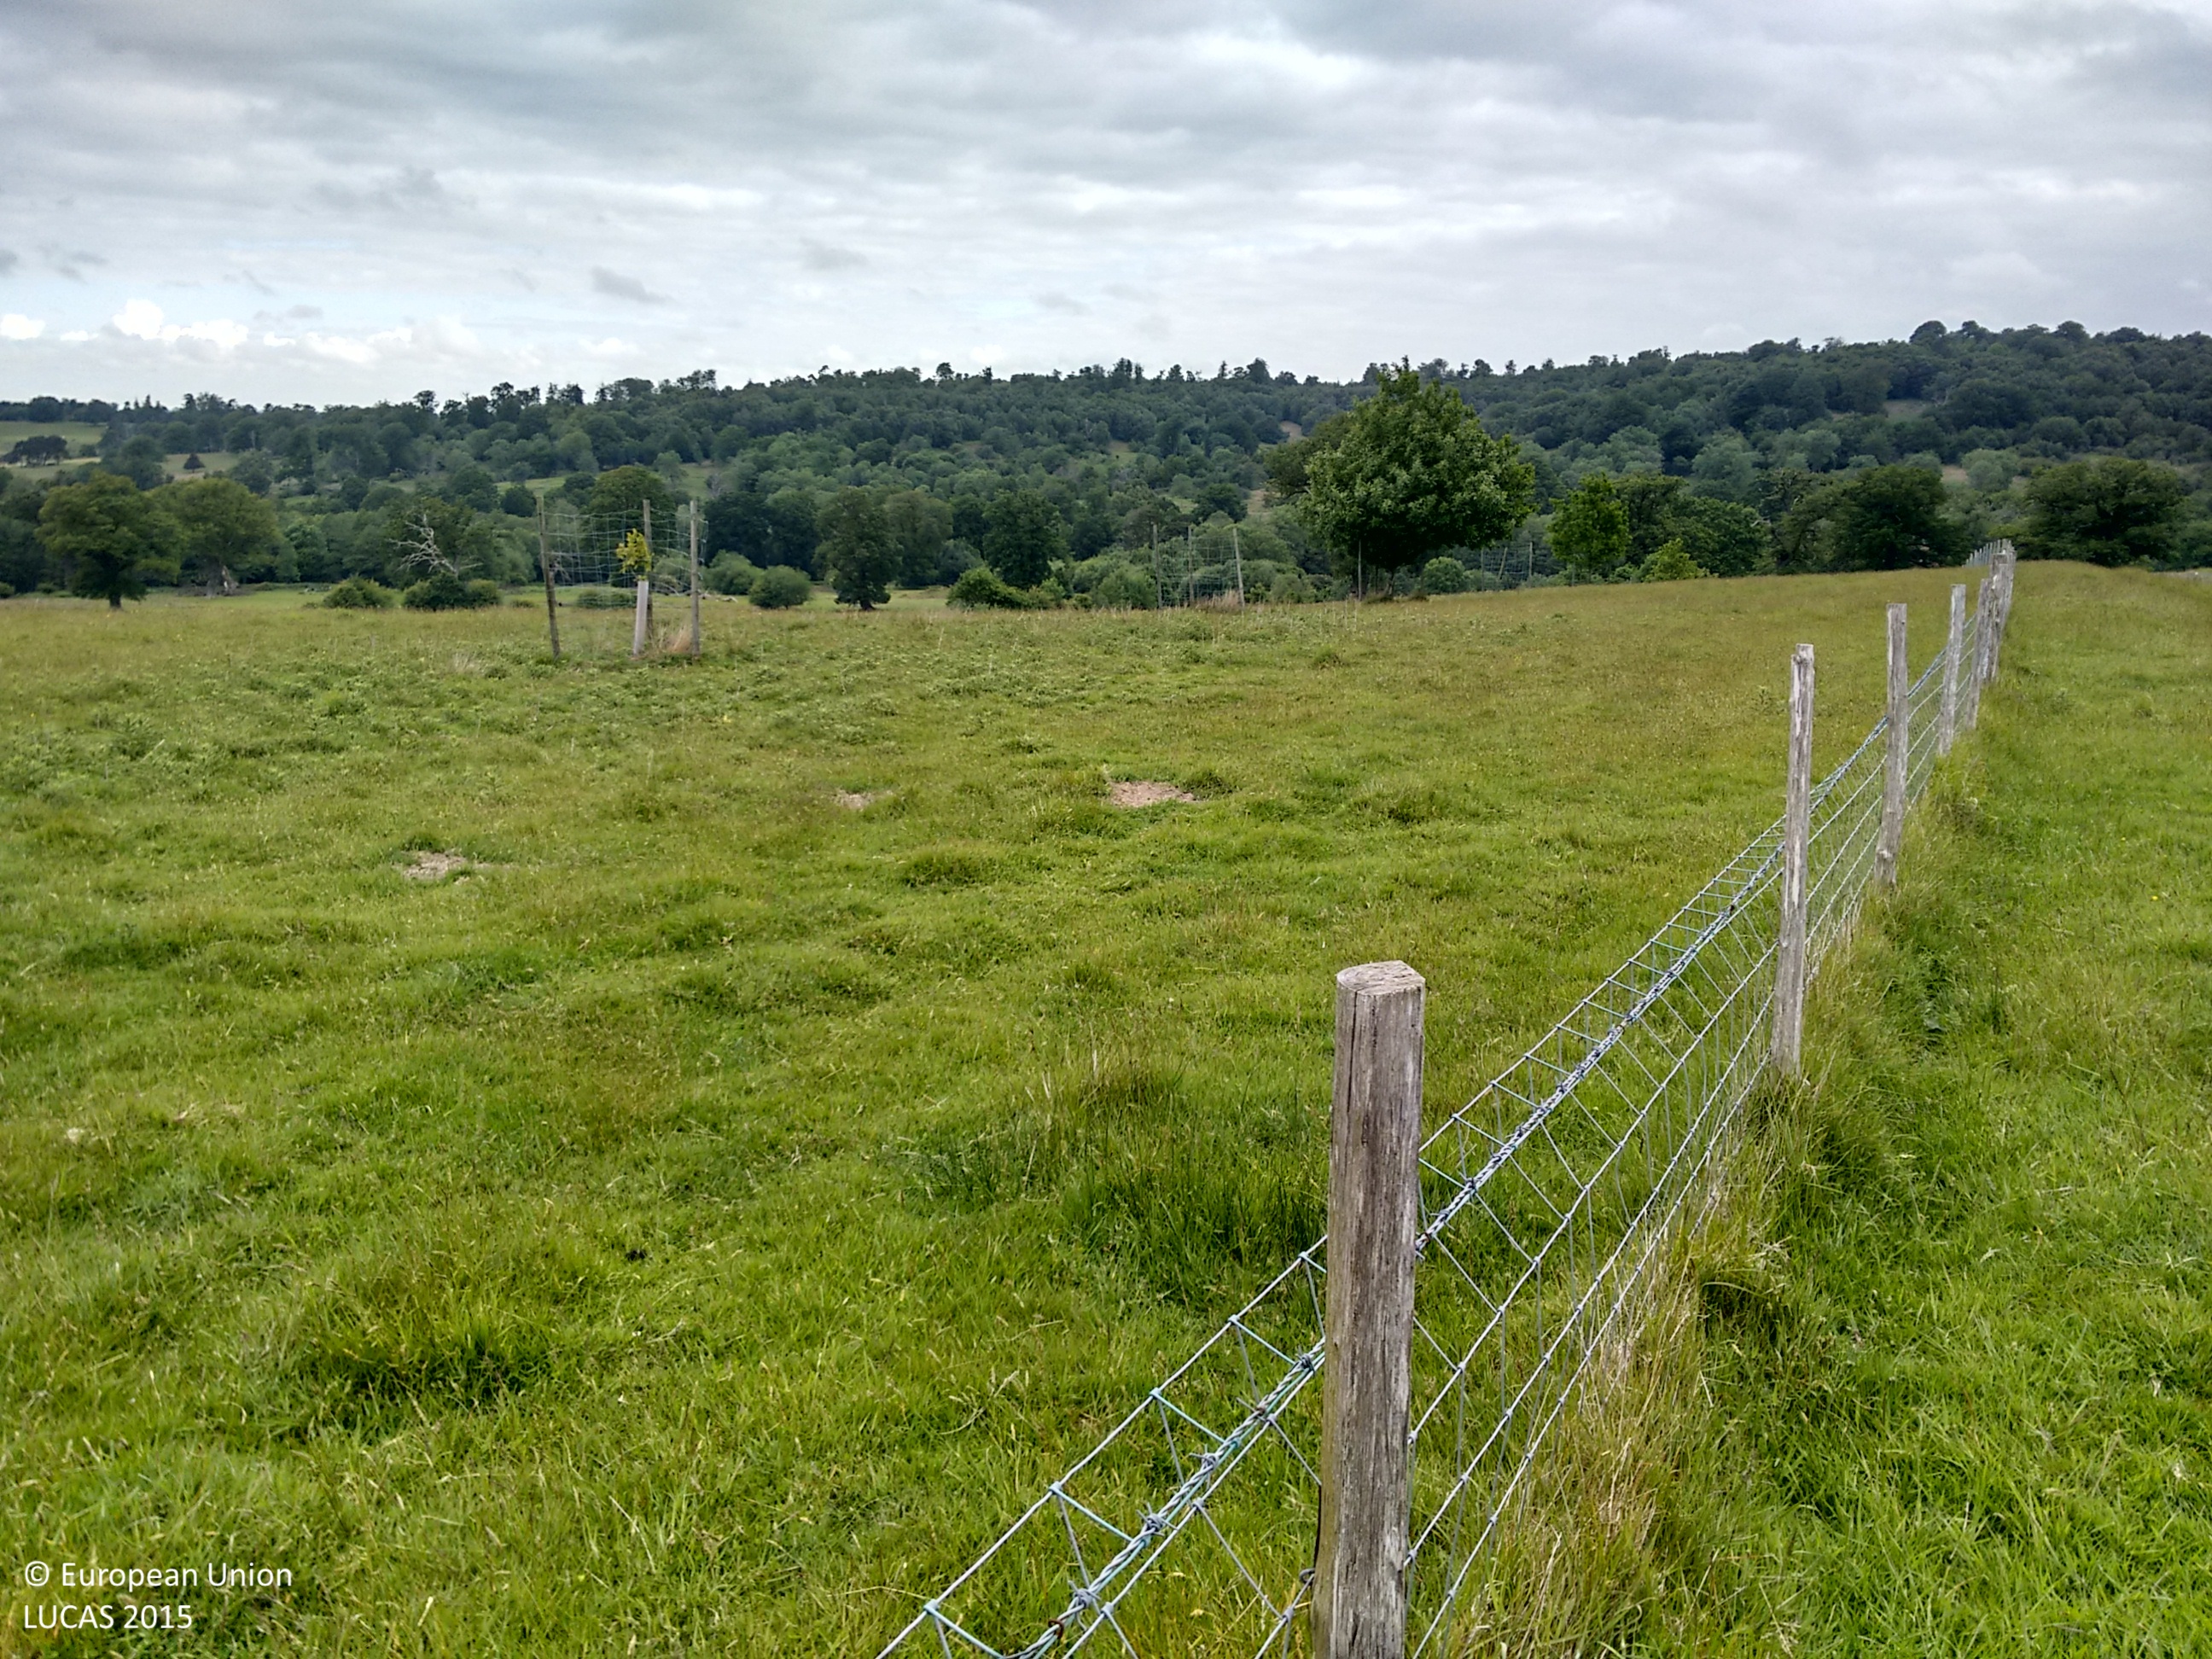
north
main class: Grassland
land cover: Grassland without tree/shrub cover
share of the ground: > 75 %
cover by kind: herbaceous plants 100 %
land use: Agriculture (excluding fallow land and kitchen gardens)
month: June
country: GB
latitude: 51.0875
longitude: 0.2473
